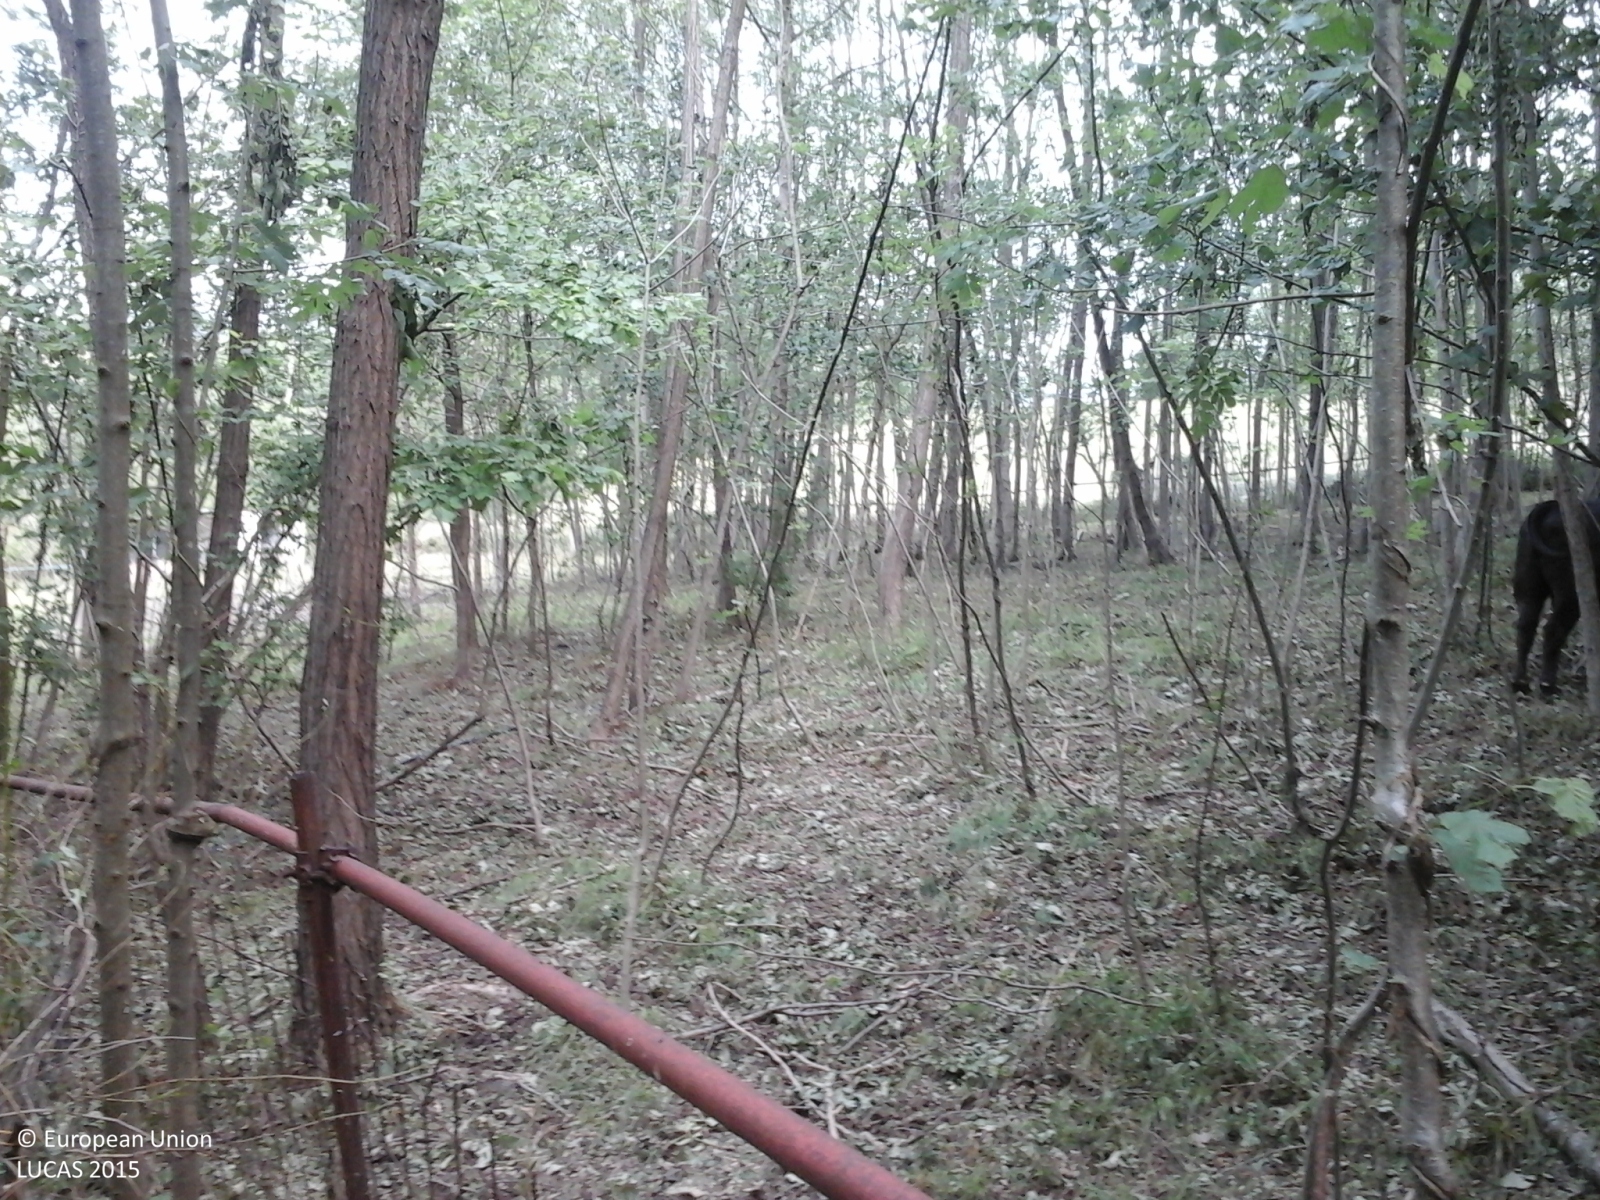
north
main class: Woodland
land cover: Broadleaved woodland
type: thermophilous deciduous forest
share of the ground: > 75 %
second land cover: Grassland without tree/shrub cover
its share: > 75 %
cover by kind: broadleaved forest trees 100 %
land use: Forestry
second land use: Agriculture (excluding fallow land and kitchen gardens)
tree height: > 5 m
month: May
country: IT
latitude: 44.7842
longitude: 7.2877
